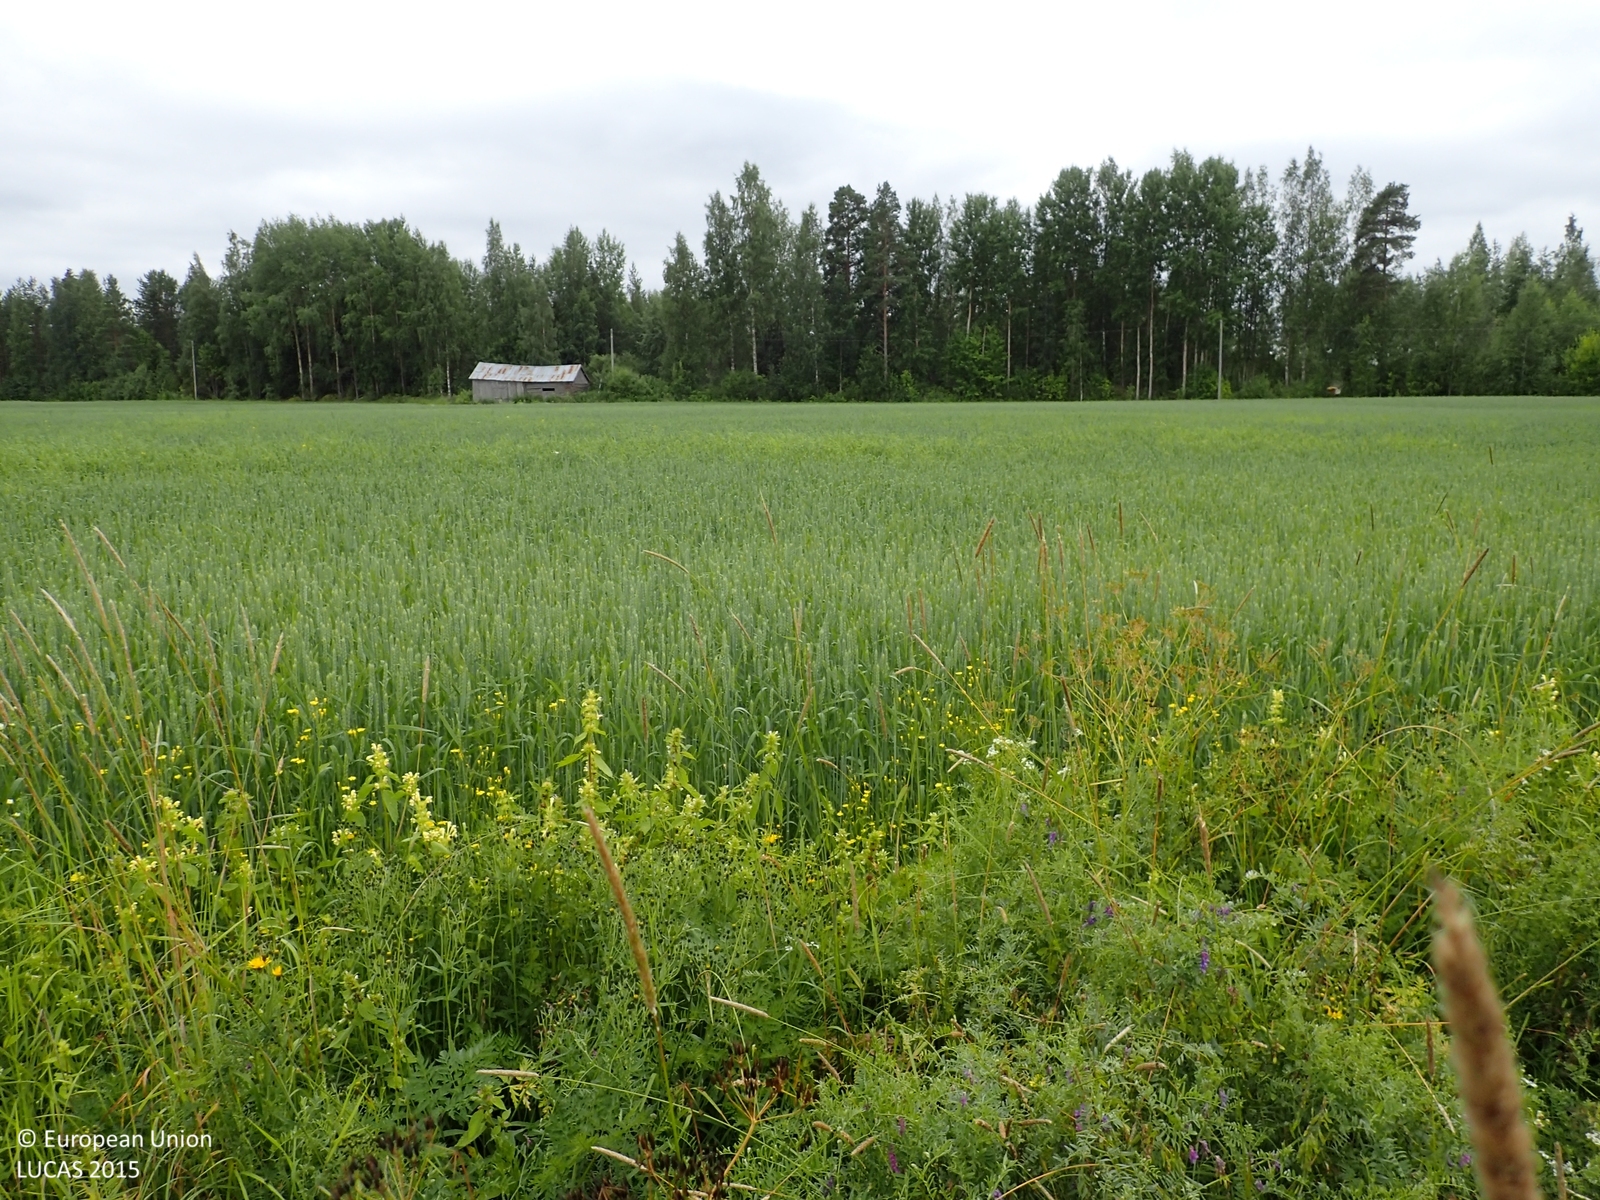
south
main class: Cropland
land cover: Barley
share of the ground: > 75 %
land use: Agriculture (excluding fallow land and kitchen gardens)
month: August
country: FI
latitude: 62.8753
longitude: 22.0591
